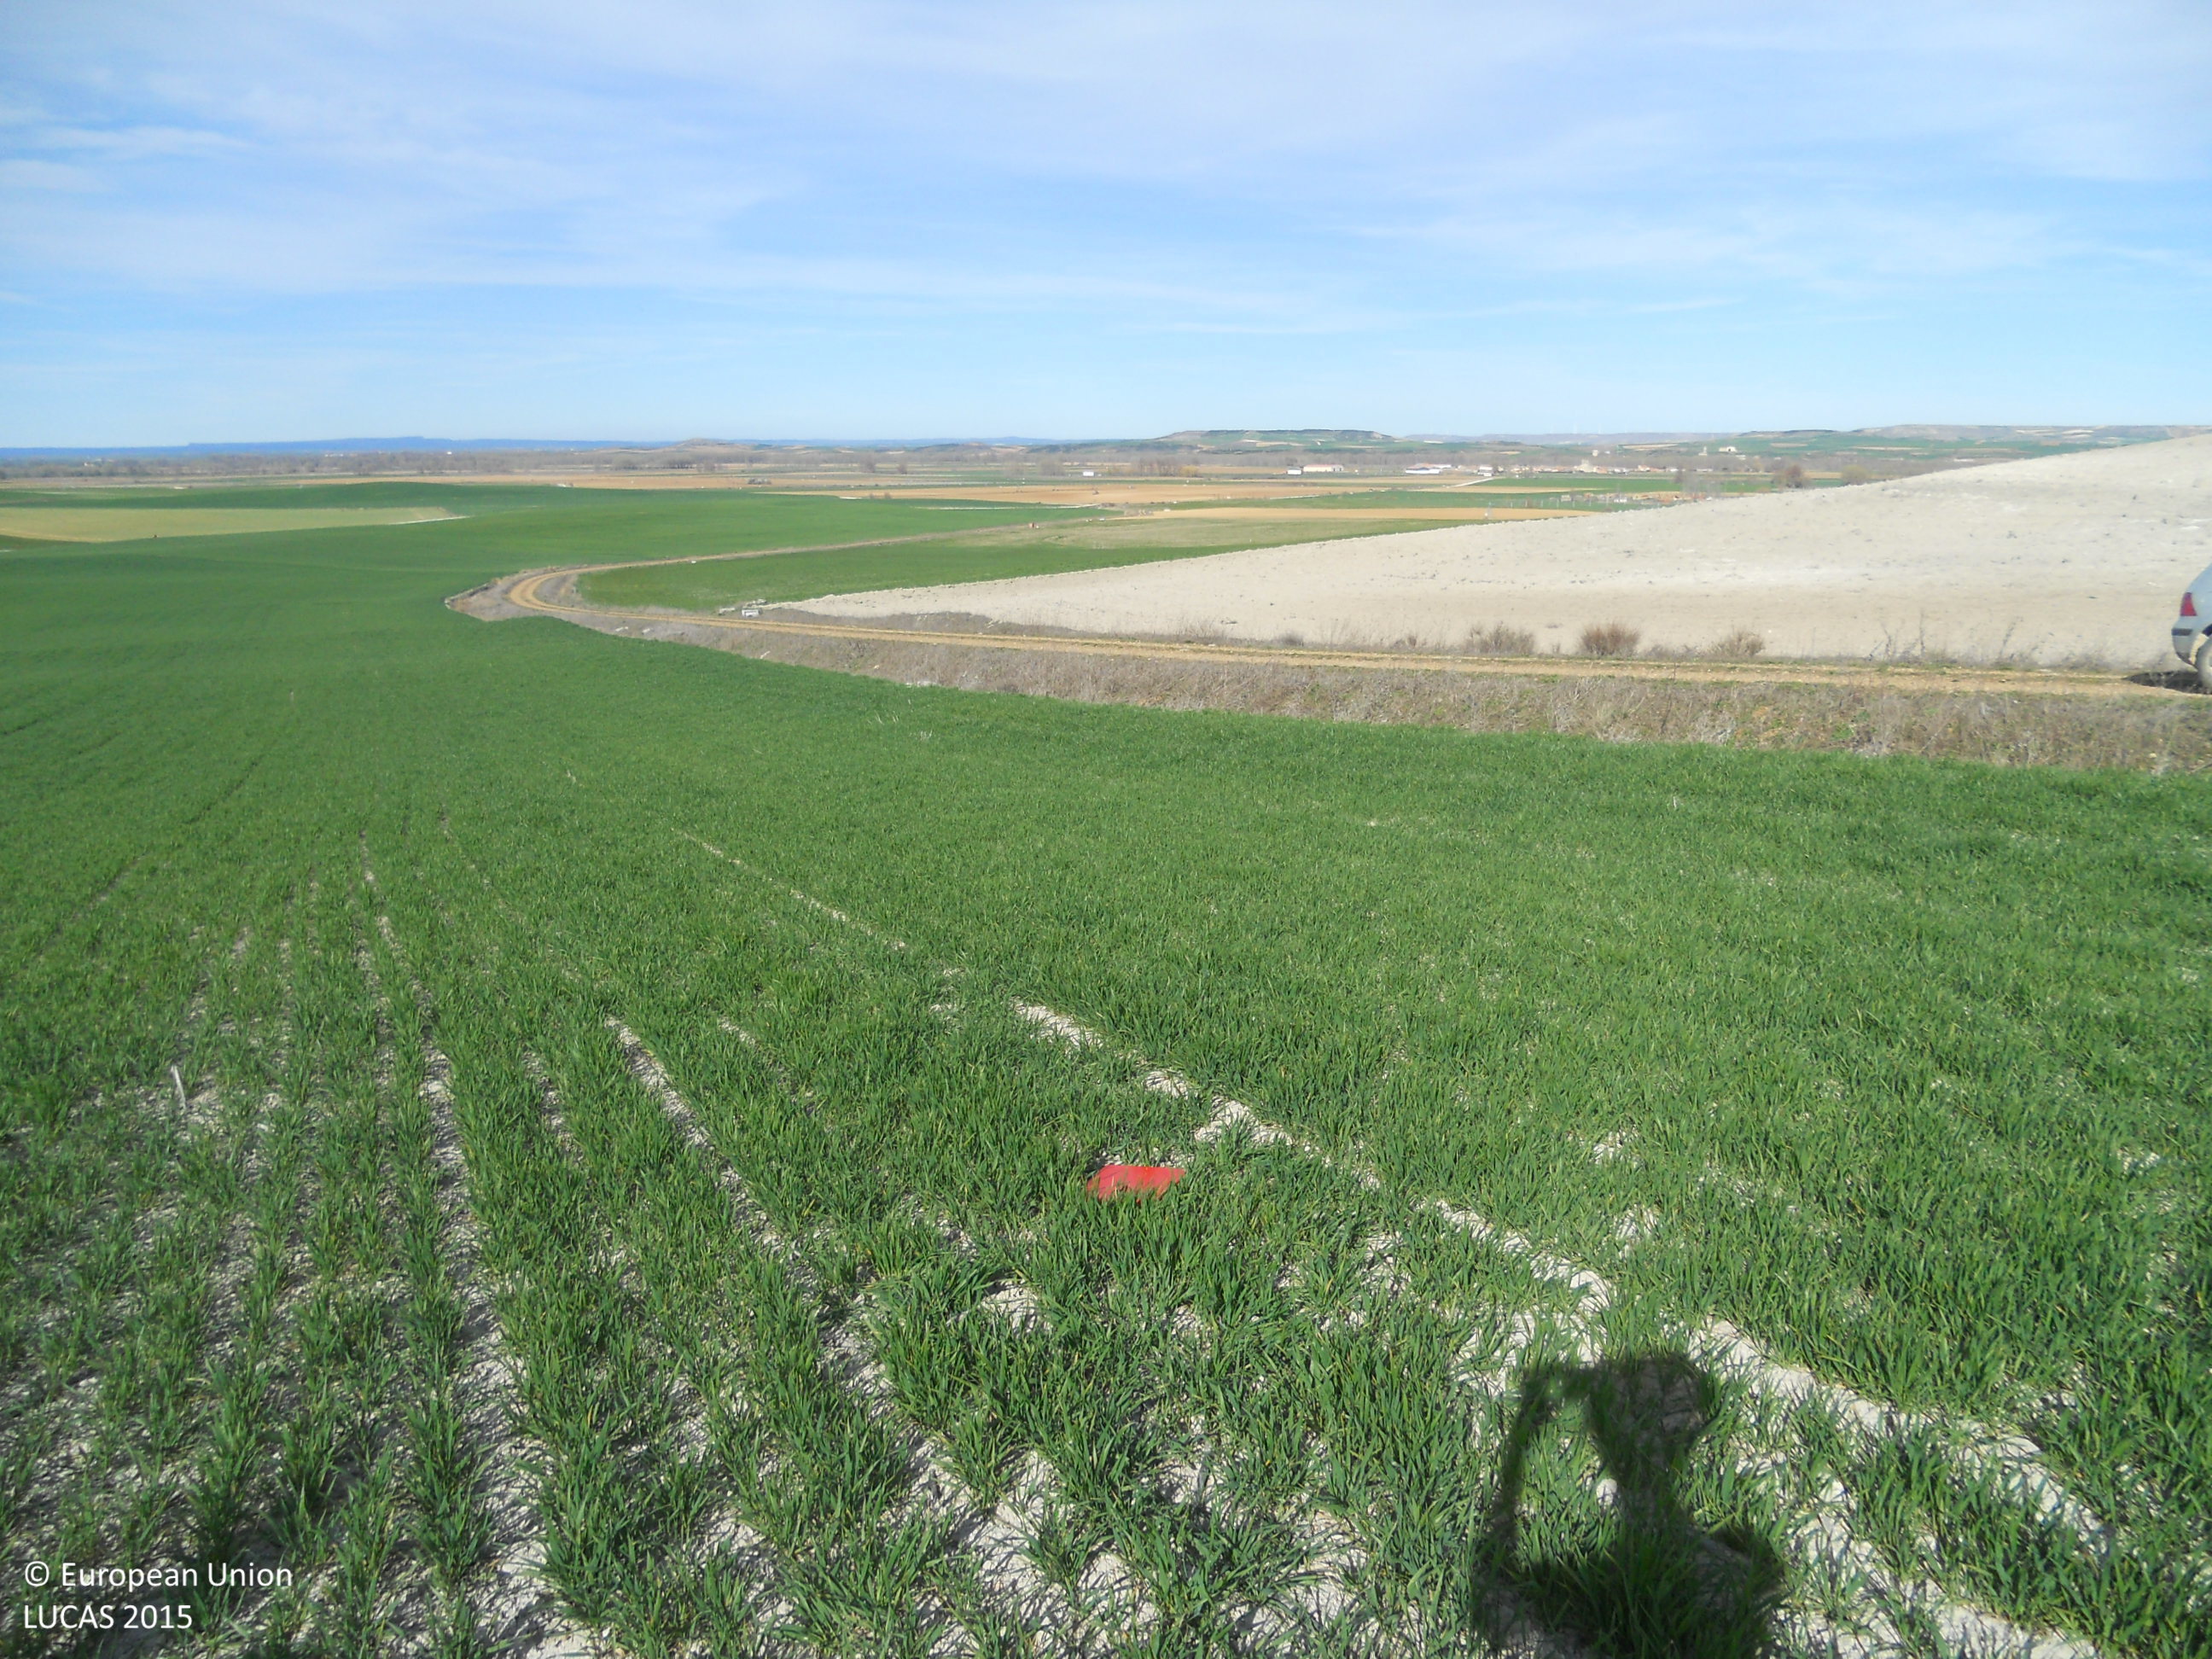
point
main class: Cropland
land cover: Barley
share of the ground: > 75 %
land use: Agriculture (excluding fallow land and kitchen gardens)
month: April
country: ES
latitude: 42.2754
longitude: -4.2921
